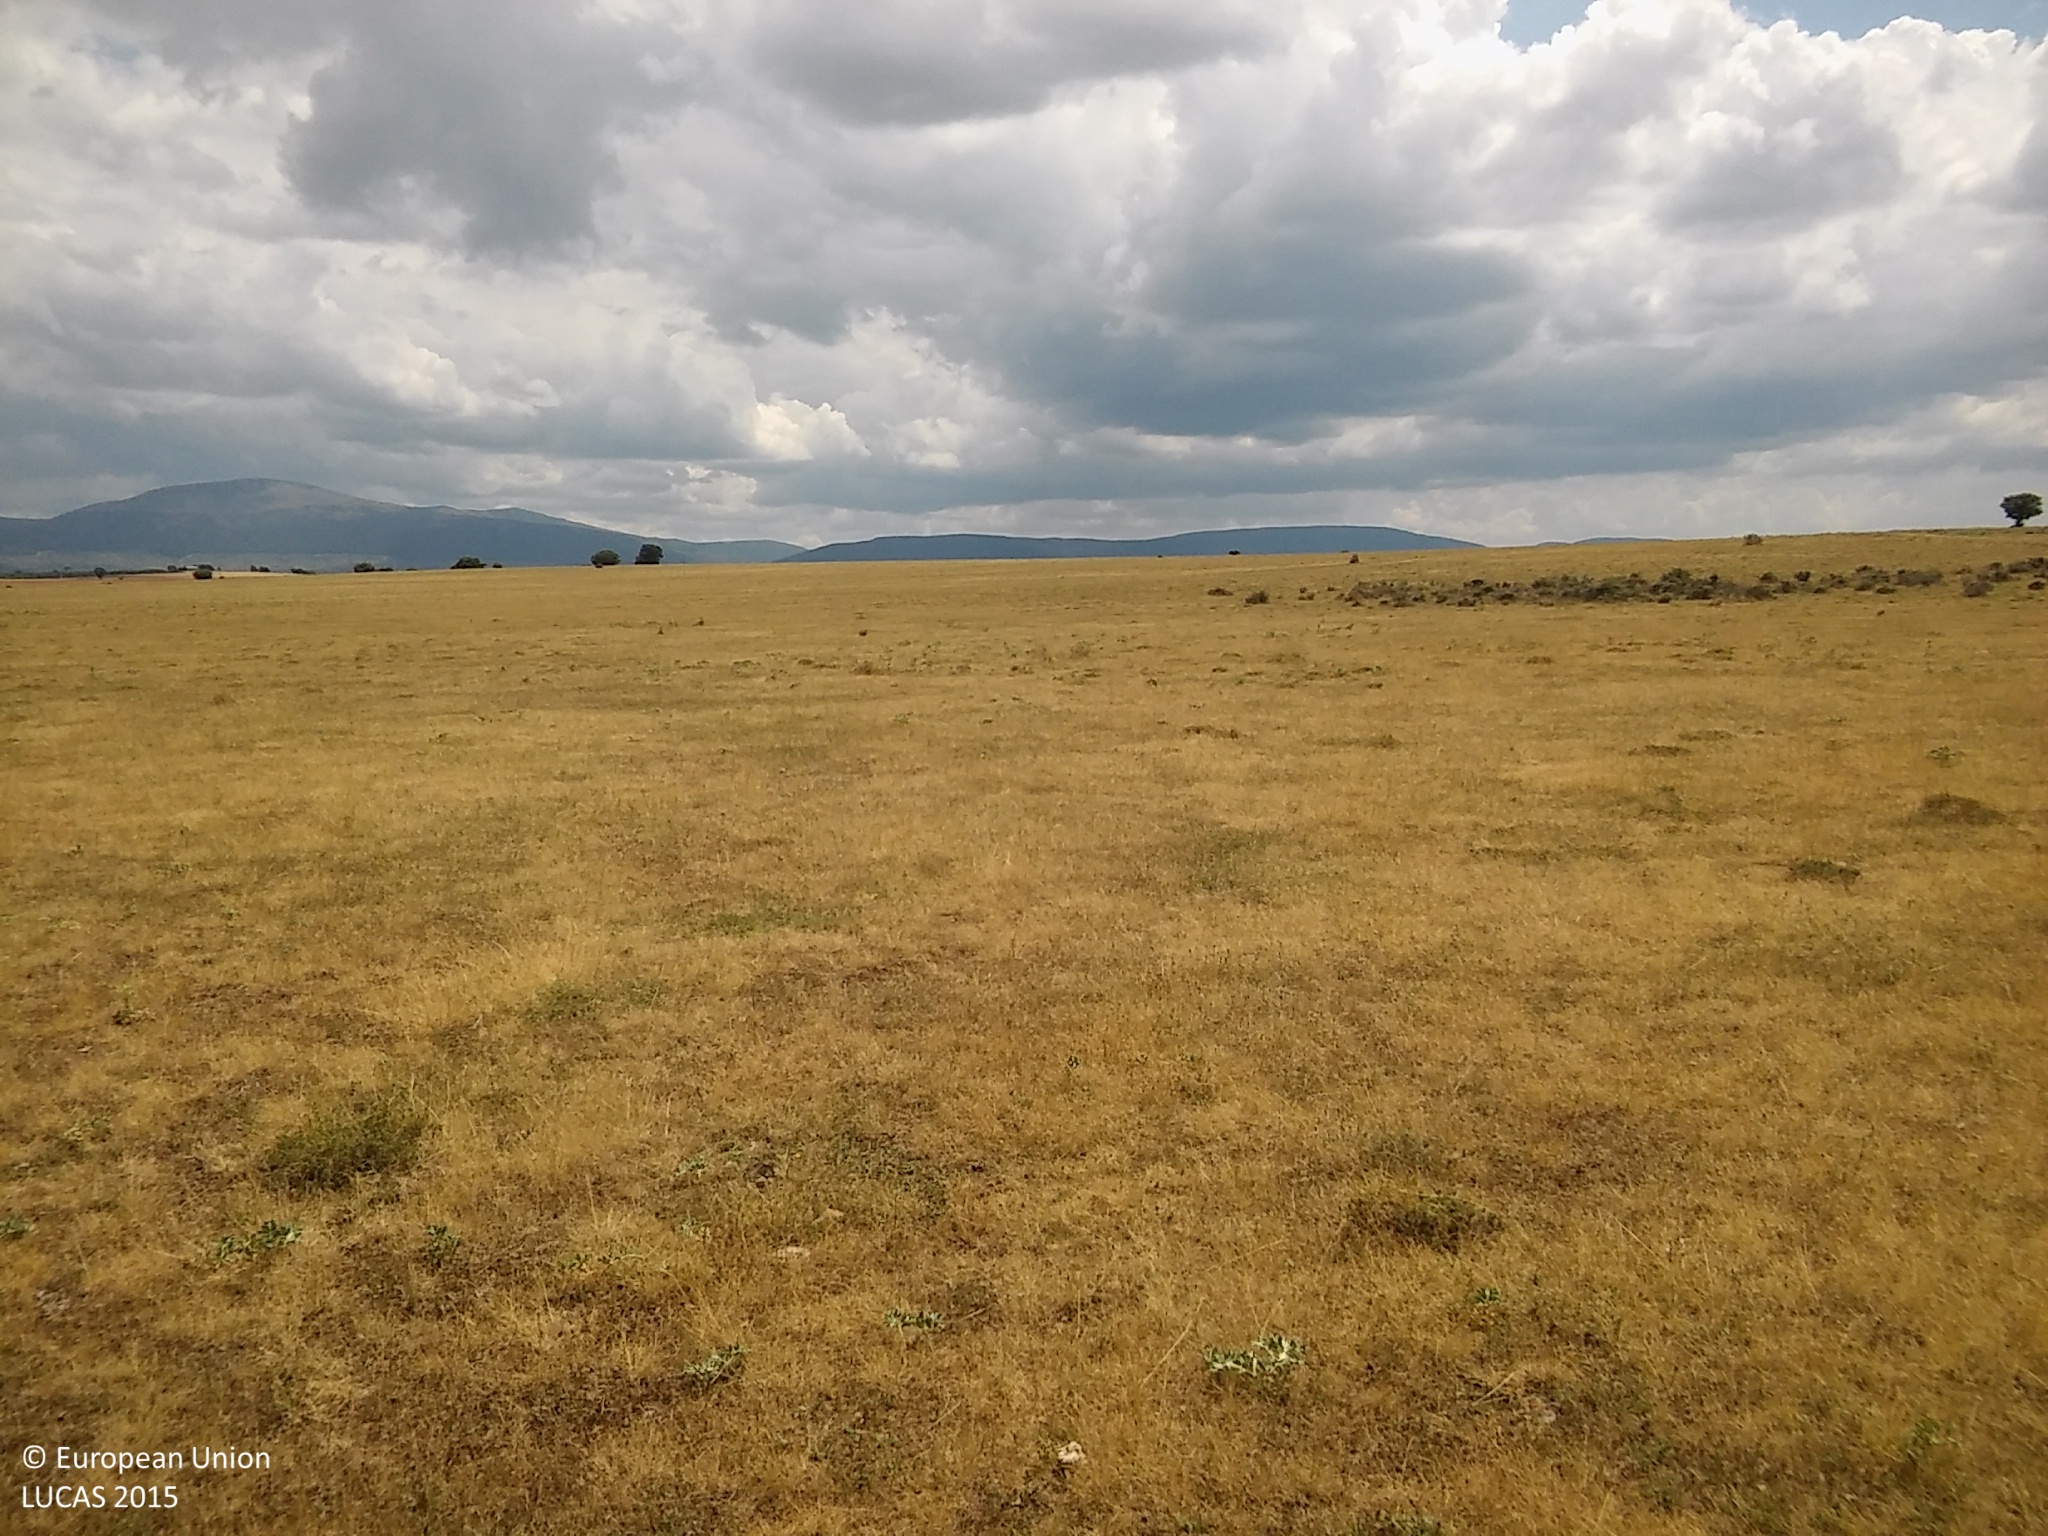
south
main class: Grassland
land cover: Grassland without tree/shrub cover
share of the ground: > 75 %
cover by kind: herbaceous plants 100 %
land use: Agriculture (excluding fallow land and kitchen gardens)
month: June
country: ES
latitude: 41.2863
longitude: -3.6476
